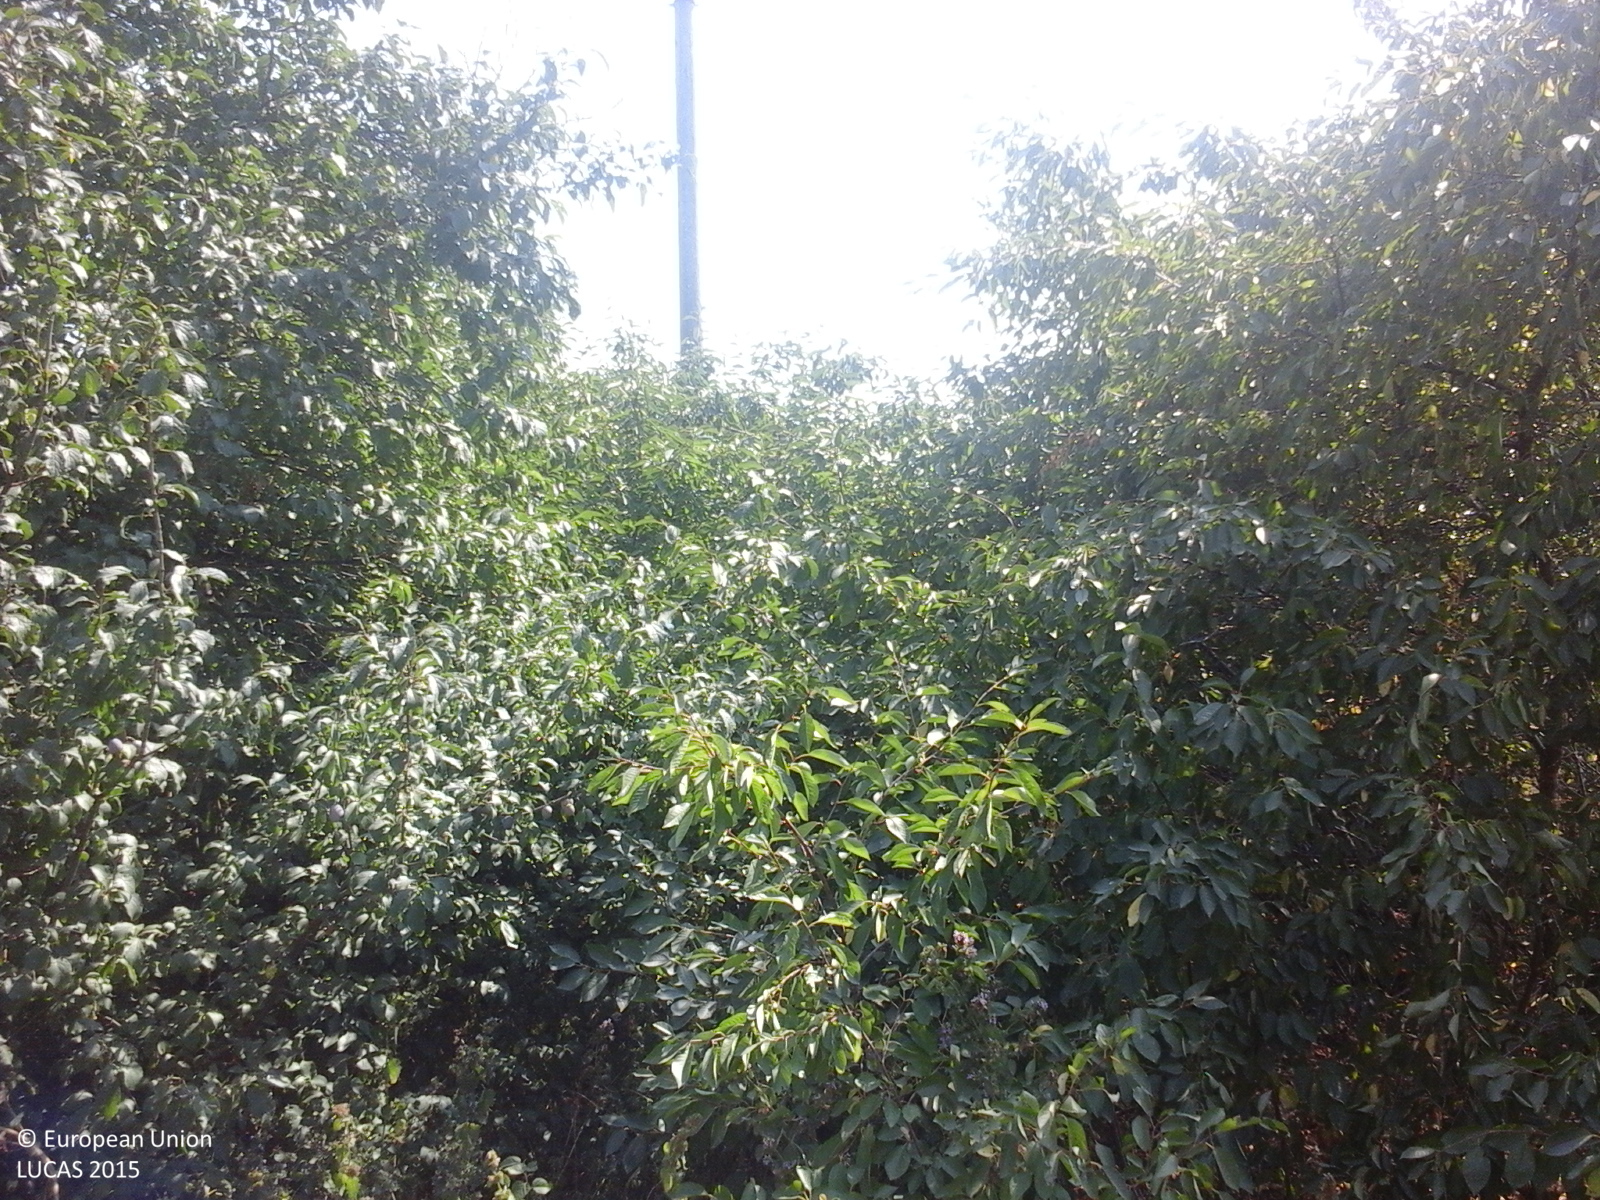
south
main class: Cropland
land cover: Apple fruit
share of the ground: > 75 %
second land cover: Grassland without tree/shrub cover
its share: > 75 %
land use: Kitchen garden
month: July
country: RO
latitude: 45.4473
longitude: 27.8198
